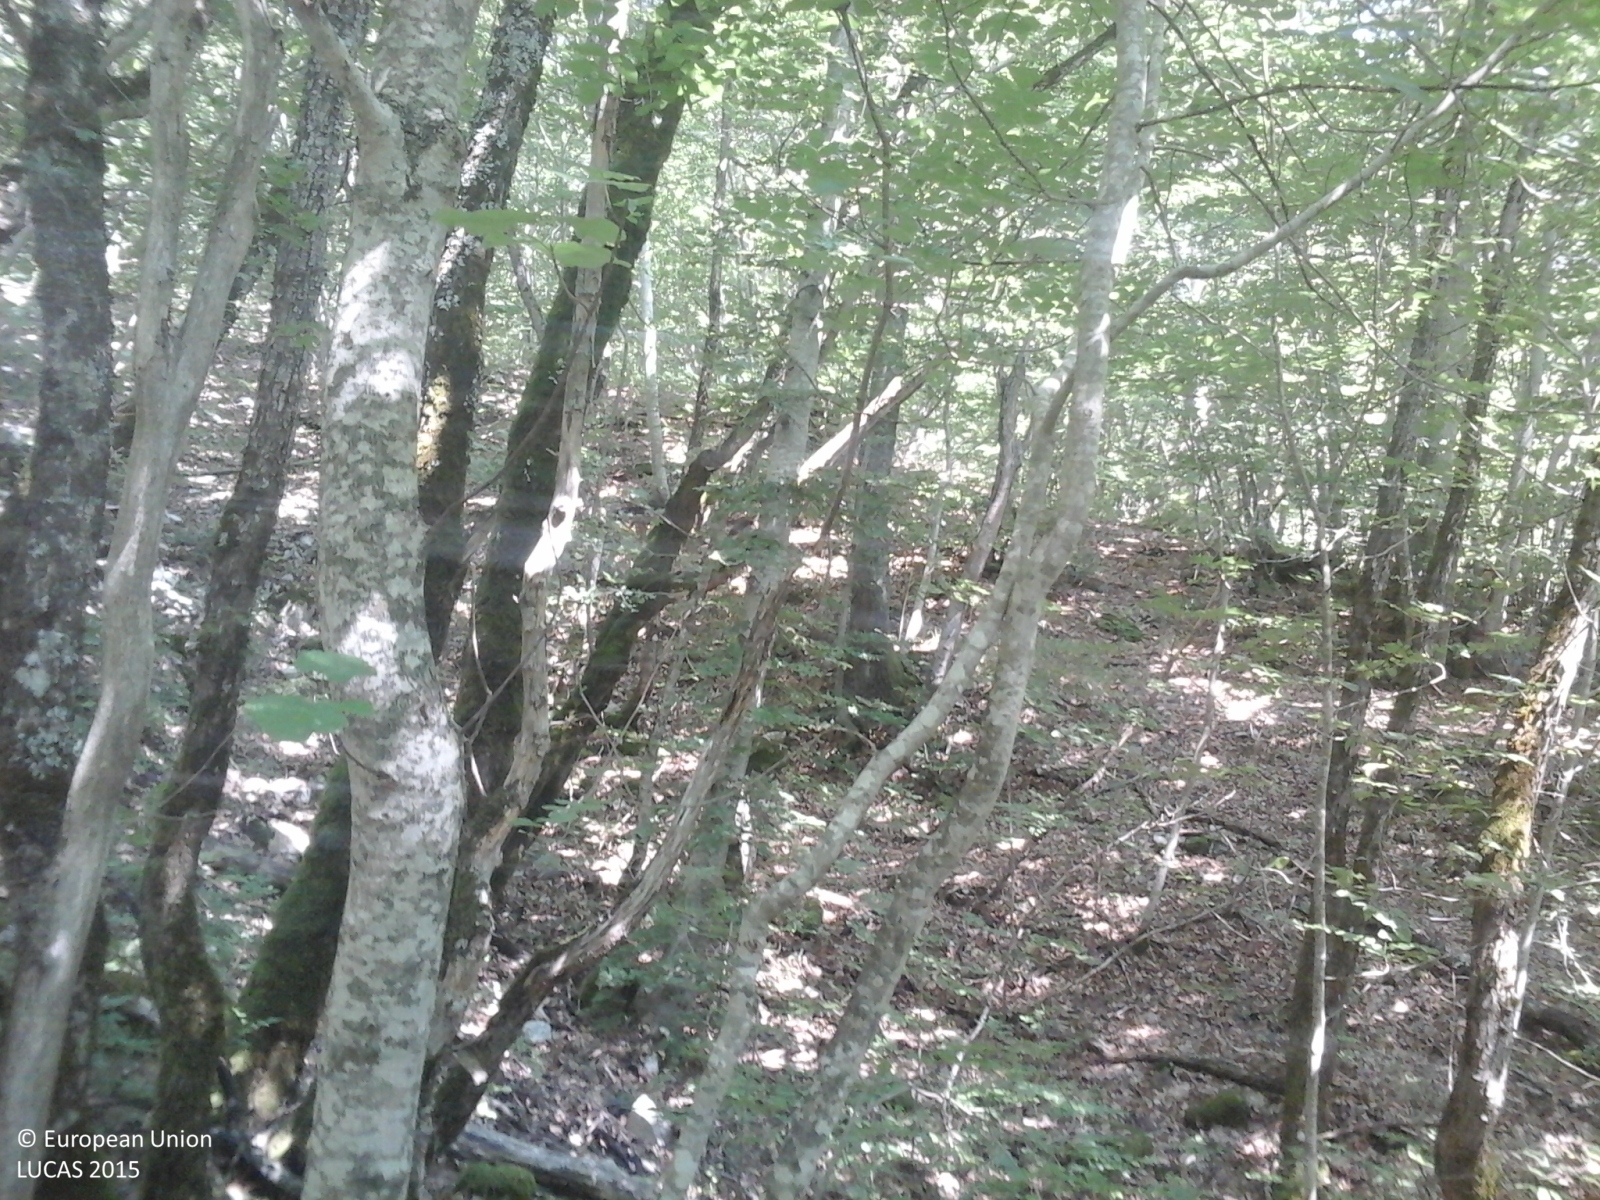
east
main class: Woodland
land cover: Broadleaved woodland
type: thermophilous deciduous forest
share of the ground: > 75 %
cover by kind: broadleaved forest trees 100 %
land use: Forestry
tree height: > 5 m
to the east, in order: Broadleaved woodland; Rivers and streams; Broadleaved woodland
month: August
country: IT
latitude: 42.9472
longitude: 13.1898
